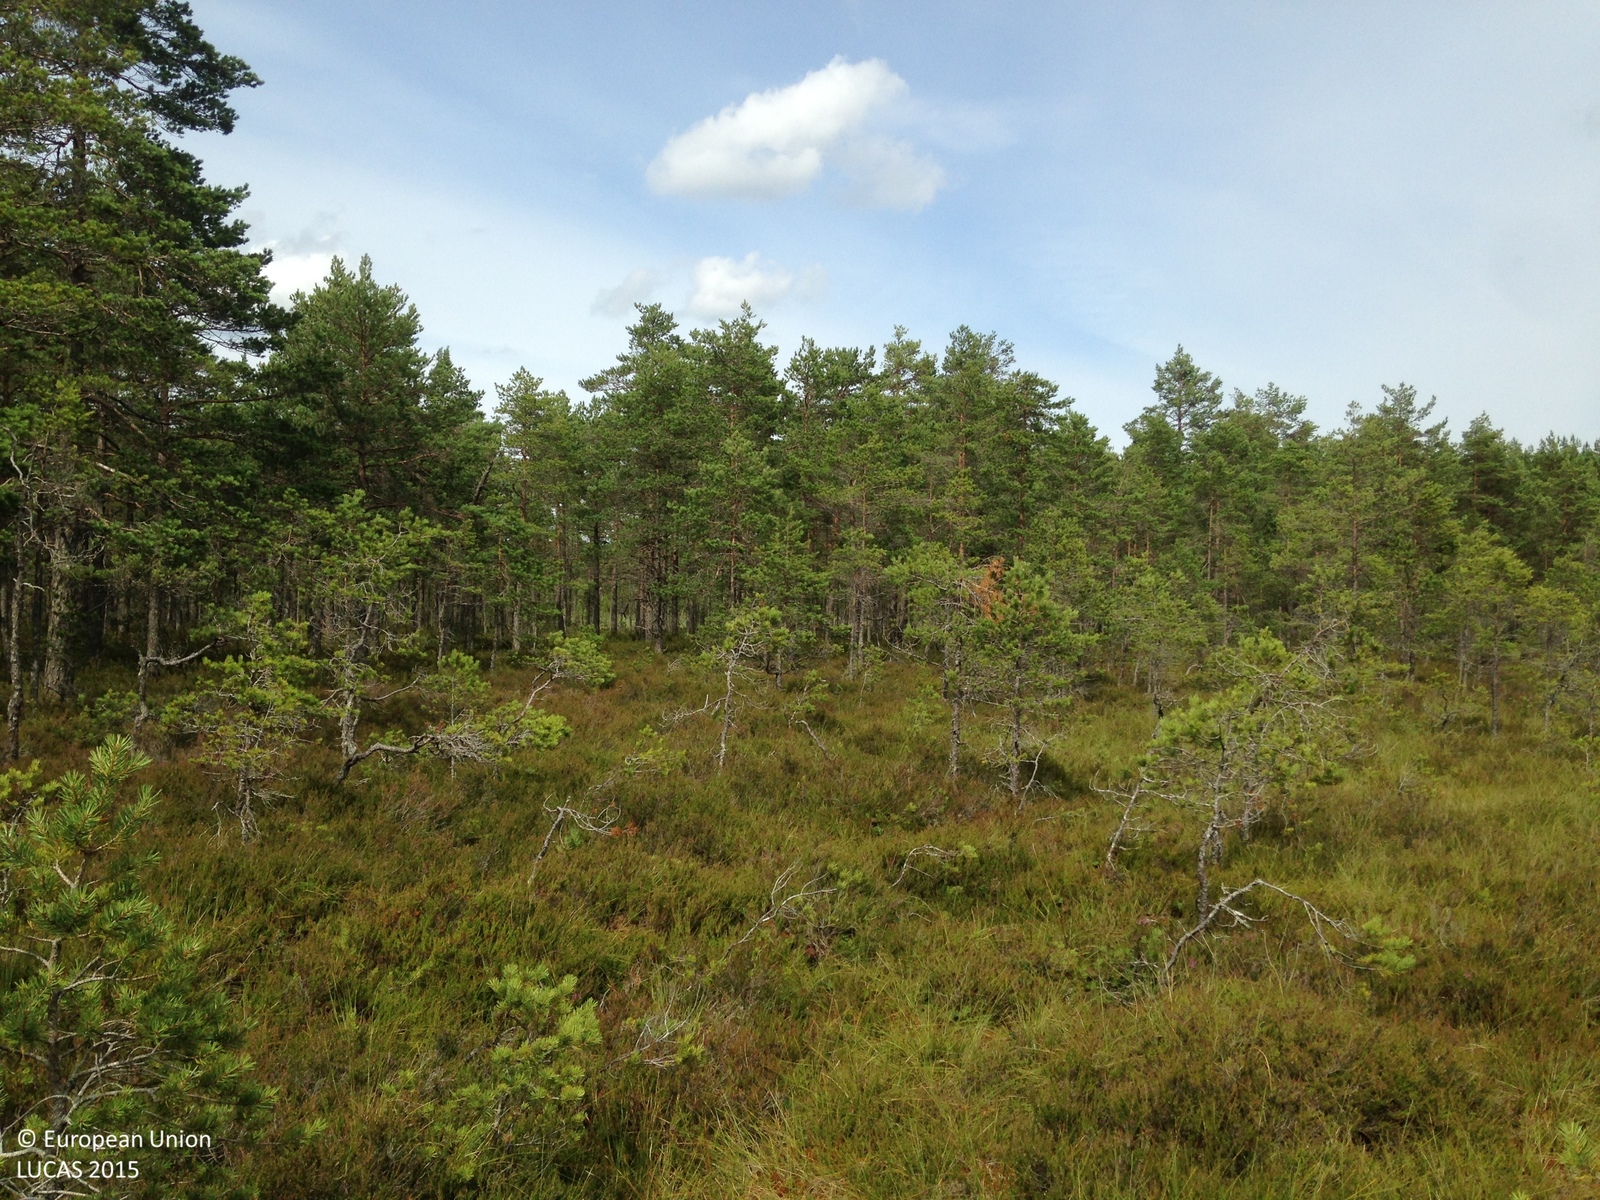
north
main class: Woodland
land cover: Pine dominated coniferous woodland
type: boreal forest
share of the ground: 10 - 25 %
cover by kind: shrubs 50 %, coniferous forest trees 20 %, lichens and mosses 20 %, herbaceous plants 10 %
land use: Semi-natural and natural areas not in use
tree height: < 5 m
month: July
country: SE
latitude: 59.0080
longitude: 14.5366
